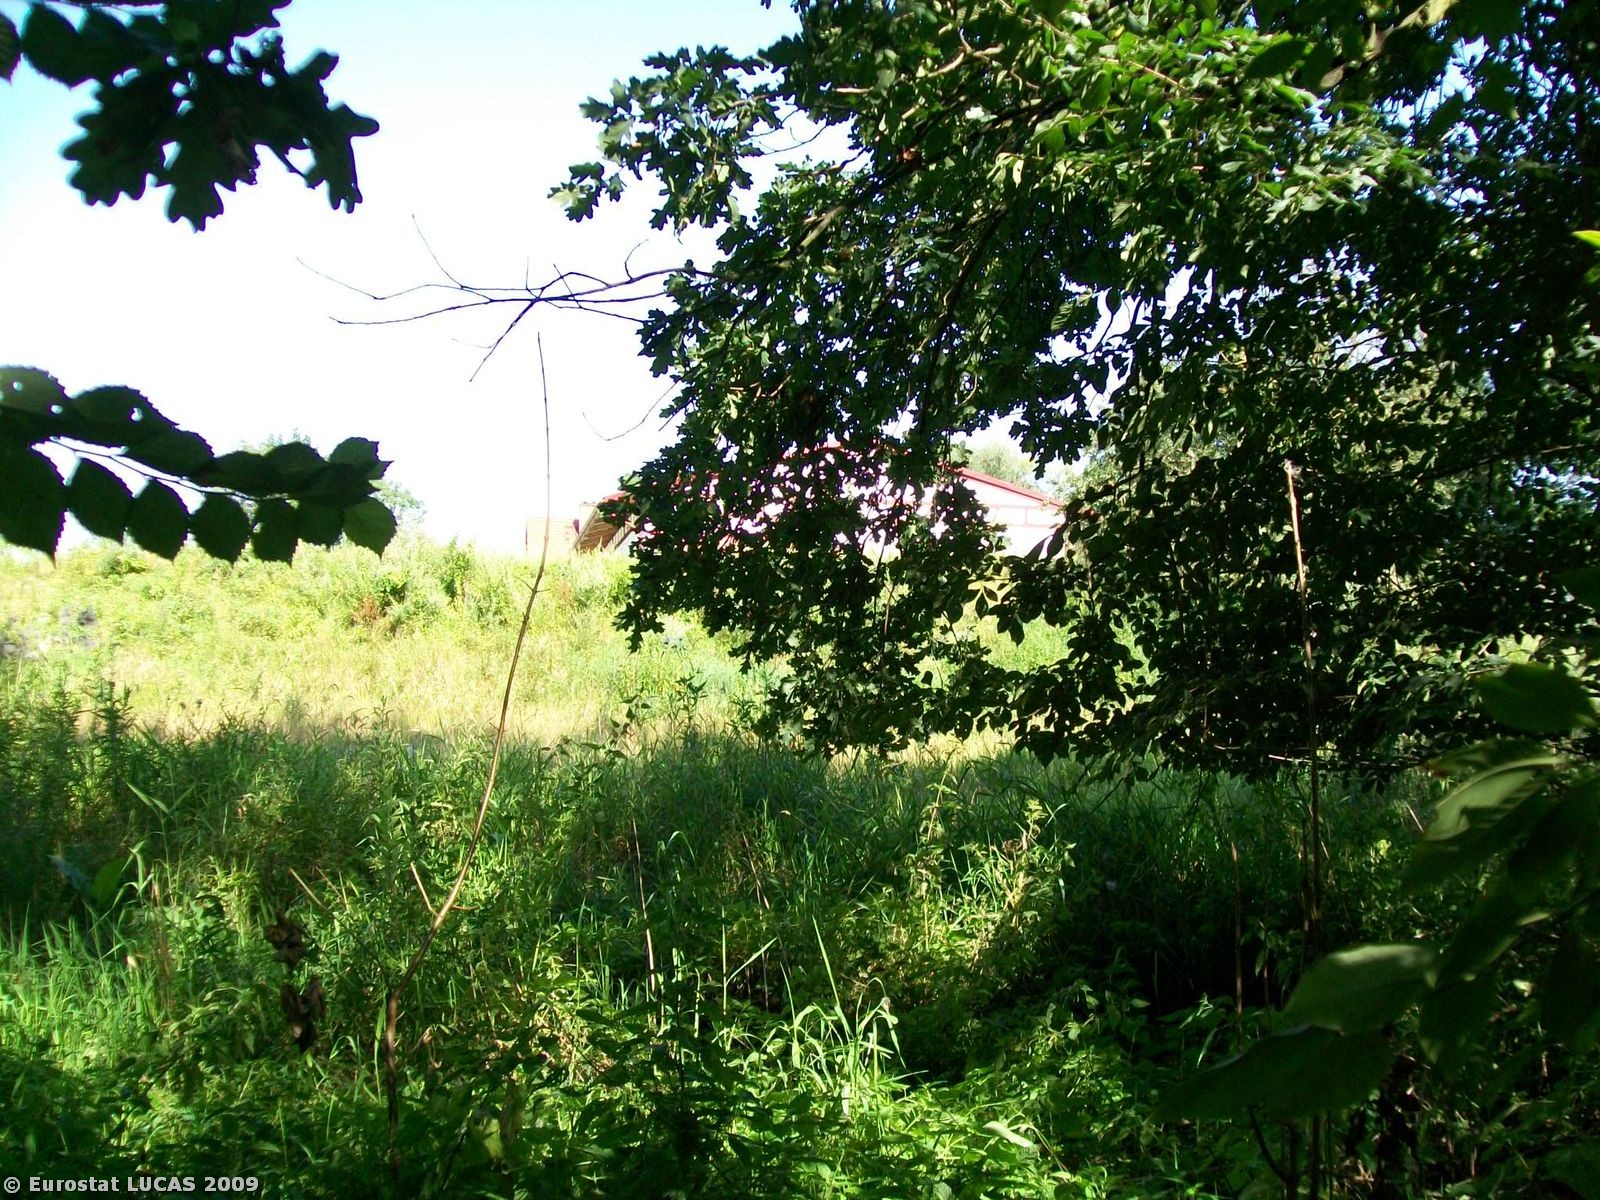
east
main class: Woodland
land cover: Broadleaved woodland
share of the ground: > 75 %
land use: Unused
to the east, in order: Broadleaved woodland; Spontaneously vegetated surfaces; Fences; Grassland without tree/shrub cover; Artificial constructions in urban areas; Grassland without tree/shrub cover; Broadleaved woodland; Abandoned hedges; Fences; Paved roads, cycling and walking lanes; Grassland without tree/shrub cover; Apple fruit; Potatoes; Common wheat; Abandoned hedges; Ditches and canals; Common wheat
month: August
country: PL
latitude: 51.0288
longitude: 16.7819
